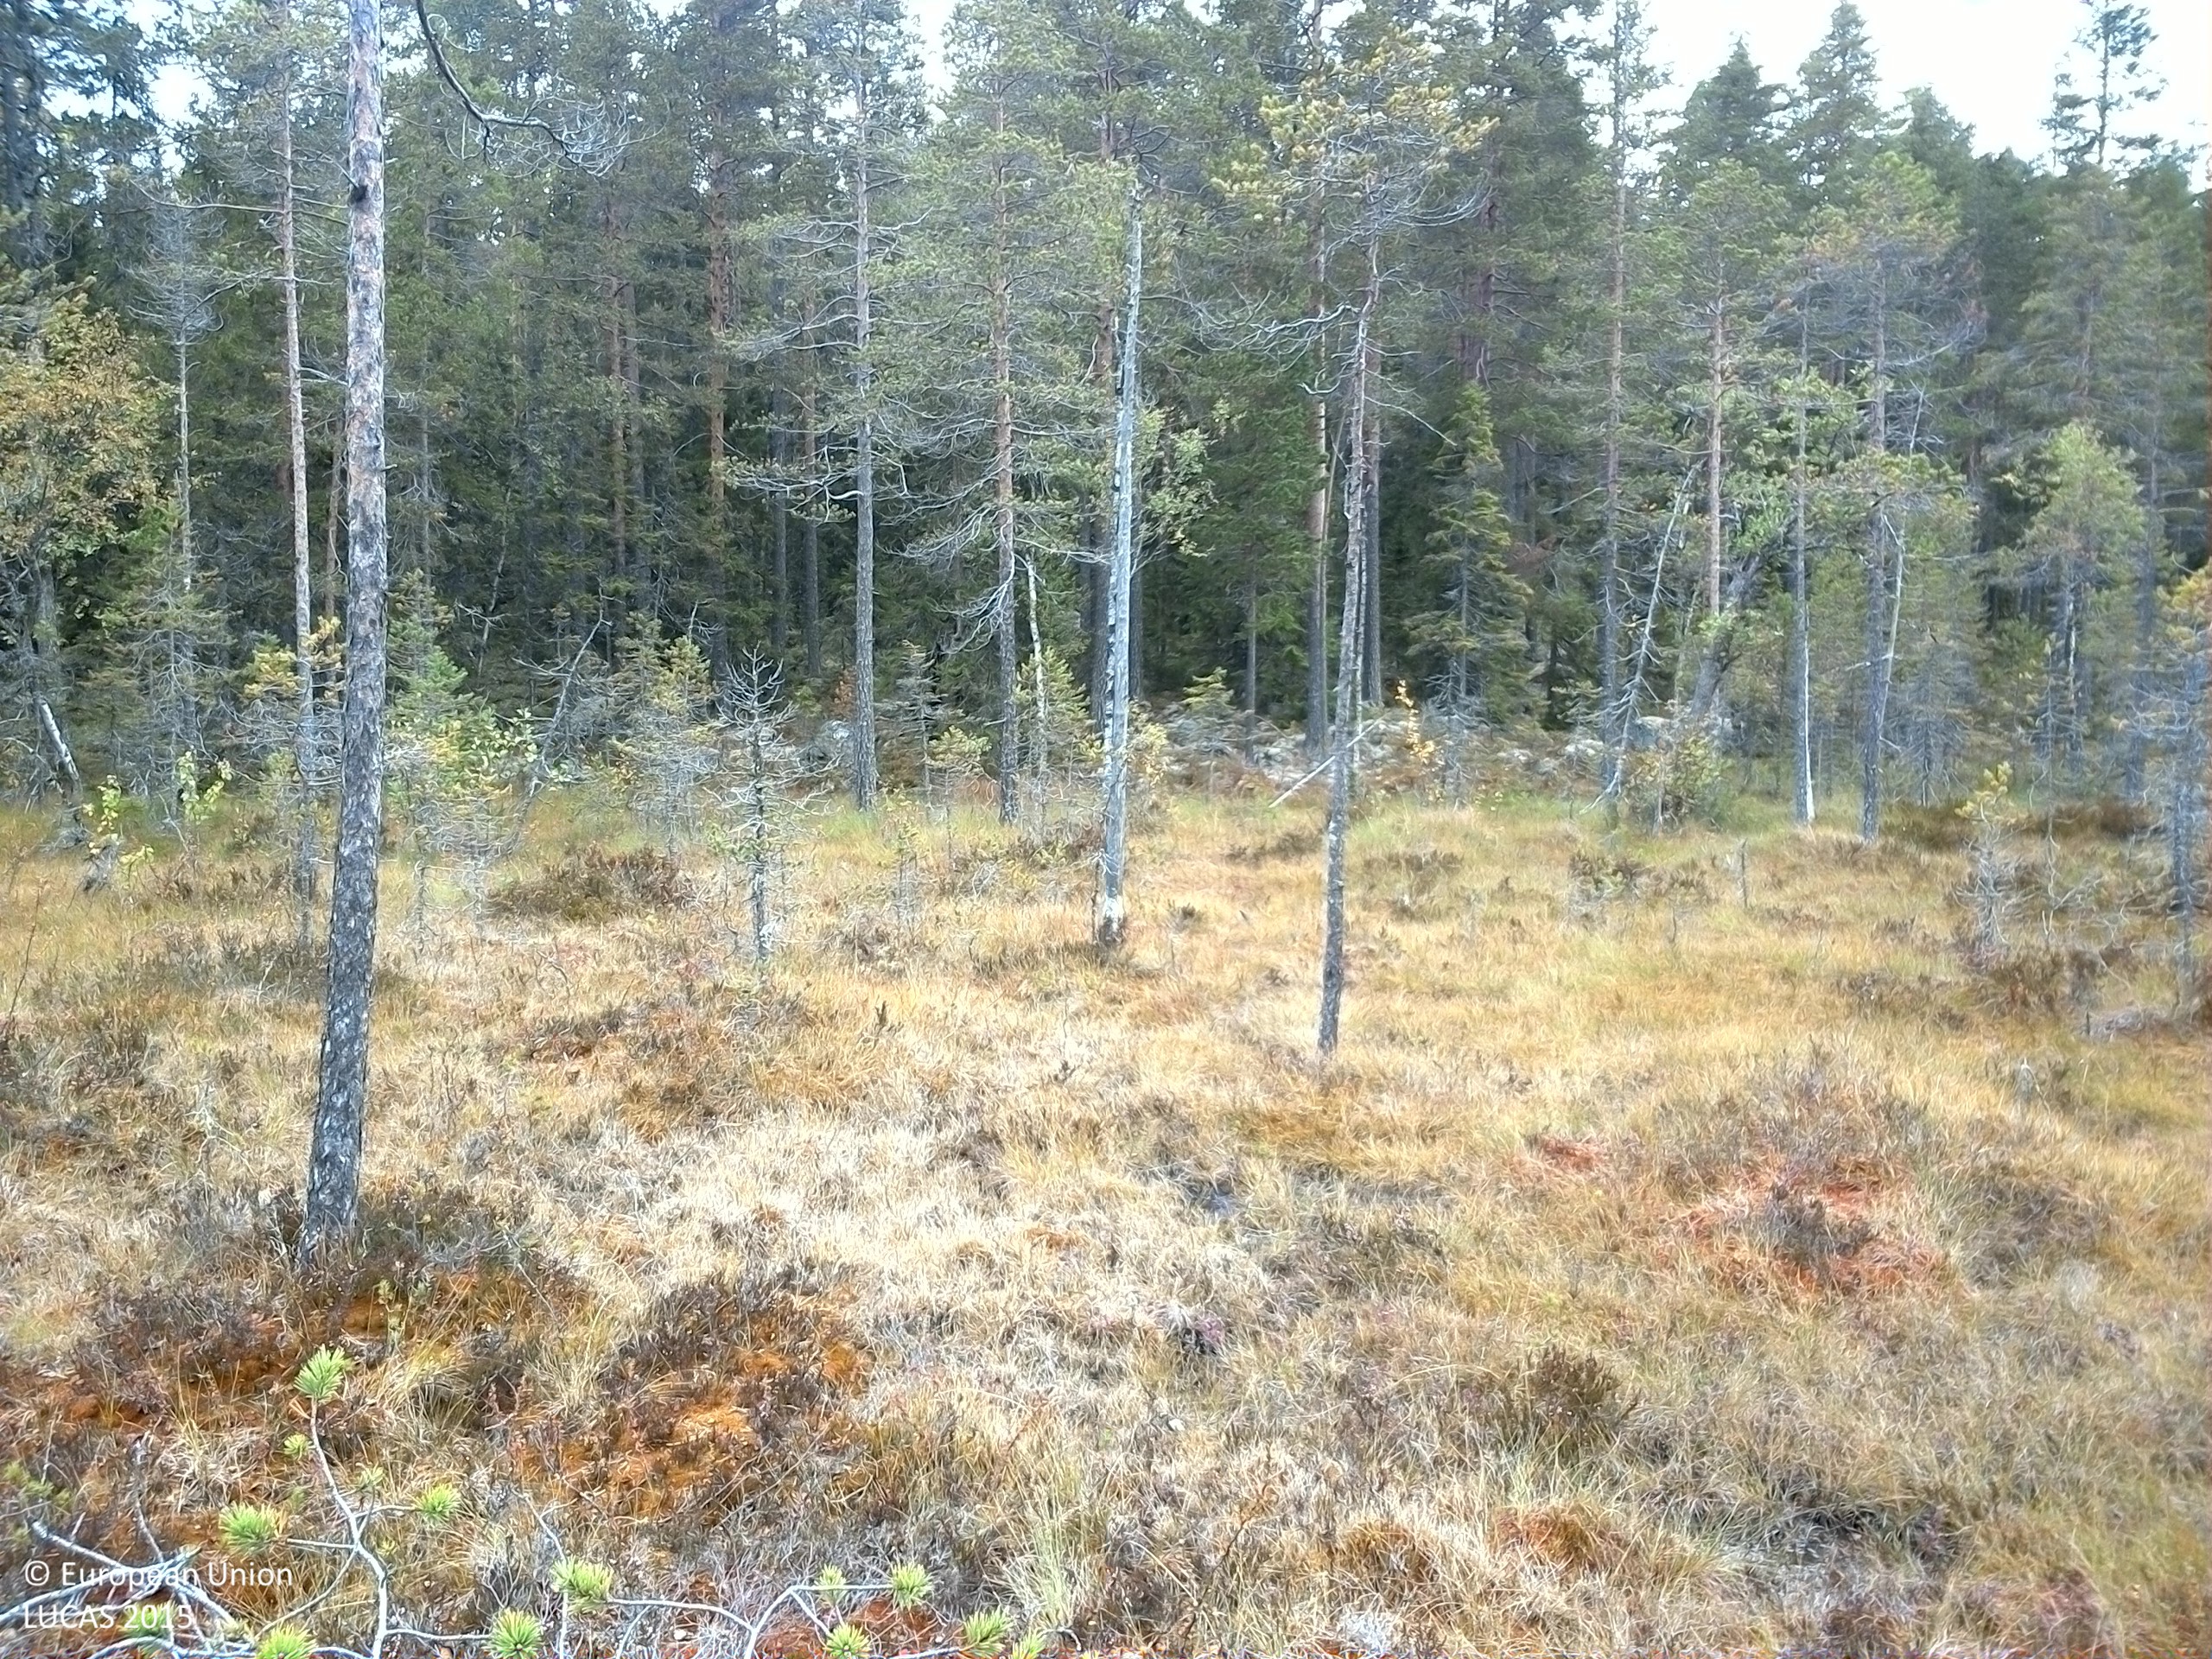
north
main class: Woodland
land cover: Pine dominated coniferous woodland
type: mire and swamp forests
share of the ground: 10 - 25 %
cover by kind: shrubs 40 %, lichens and mosses 40 %, coniferous forest trees 20 %
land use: Semi-natural and natural areas not in use
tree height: < 5 m
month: September
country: SE
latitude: 61.5344
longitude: 15.0434
